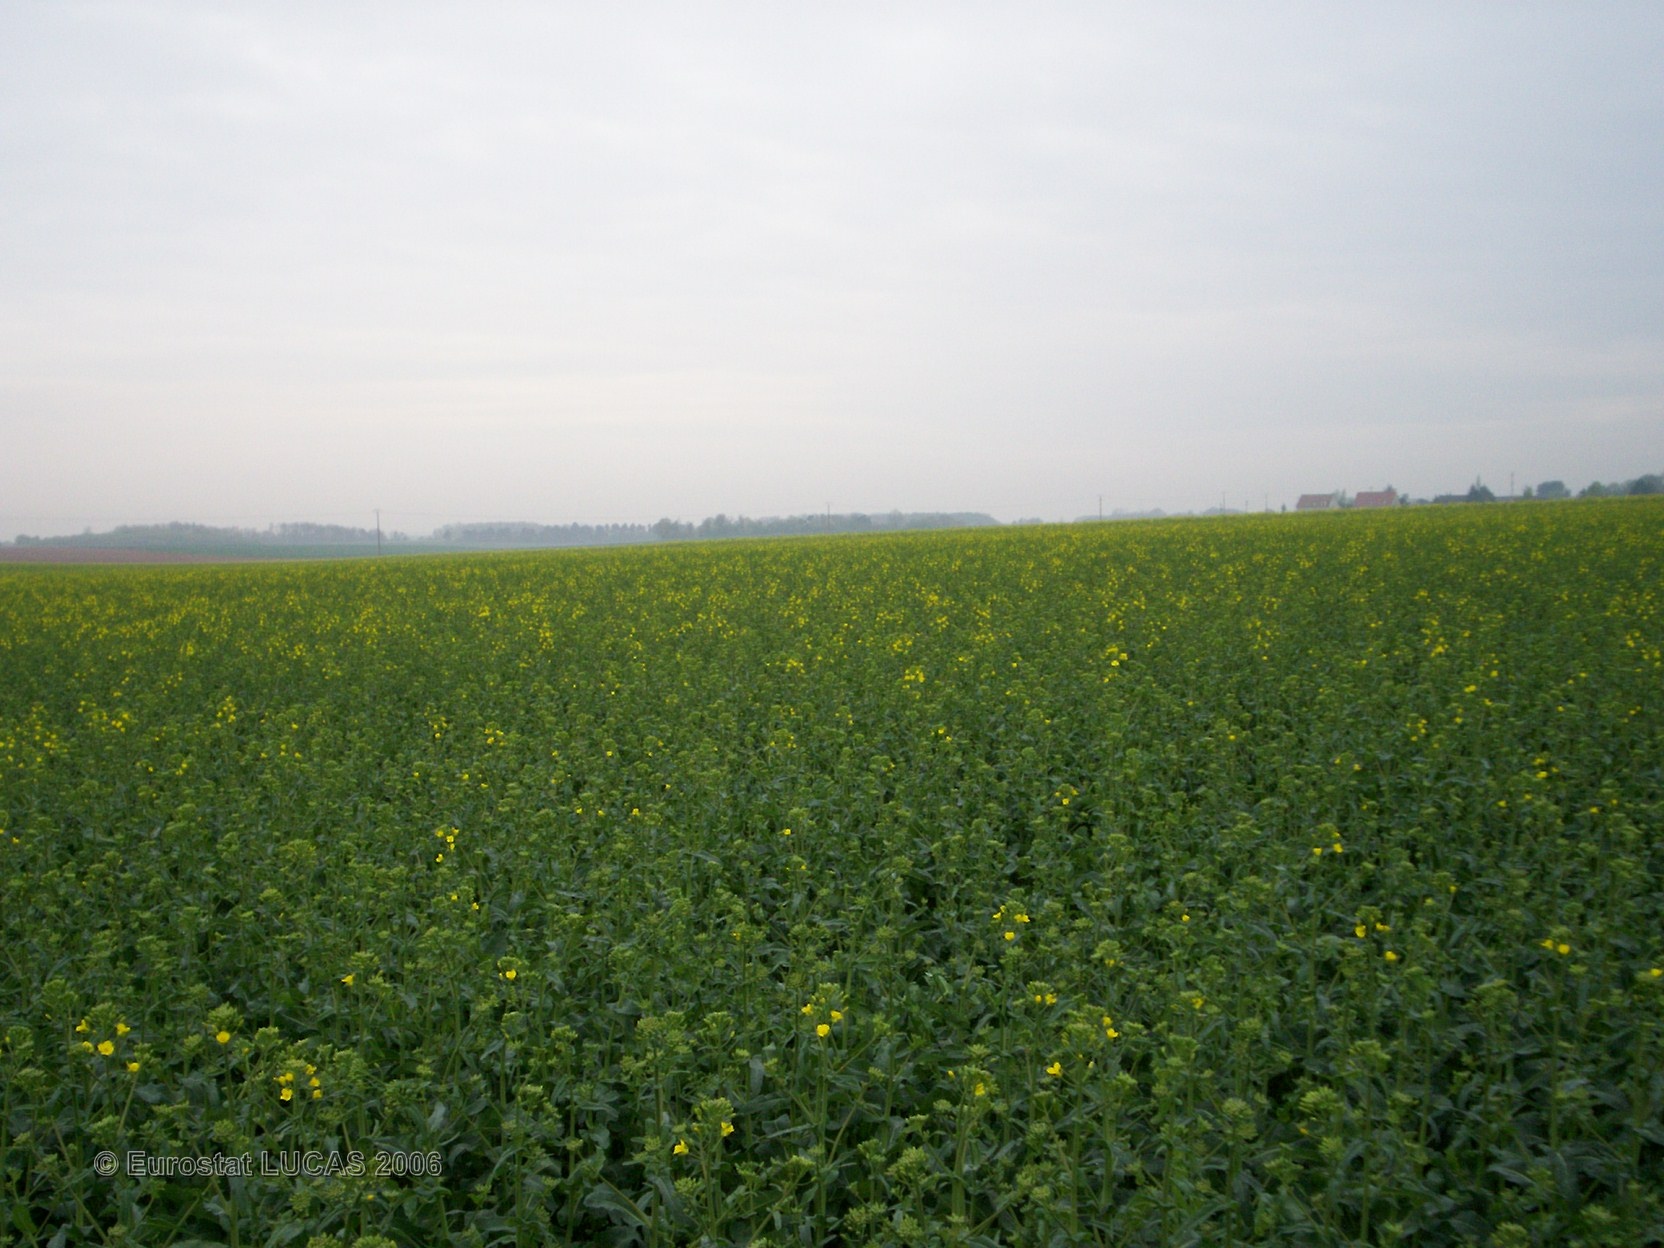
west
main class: Cropland
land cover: Rape and turnip rape
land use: Agriculture (excluding fallow land and kitchen gardens)
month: April
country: FR
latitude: 48.2222
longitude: 2.7901
